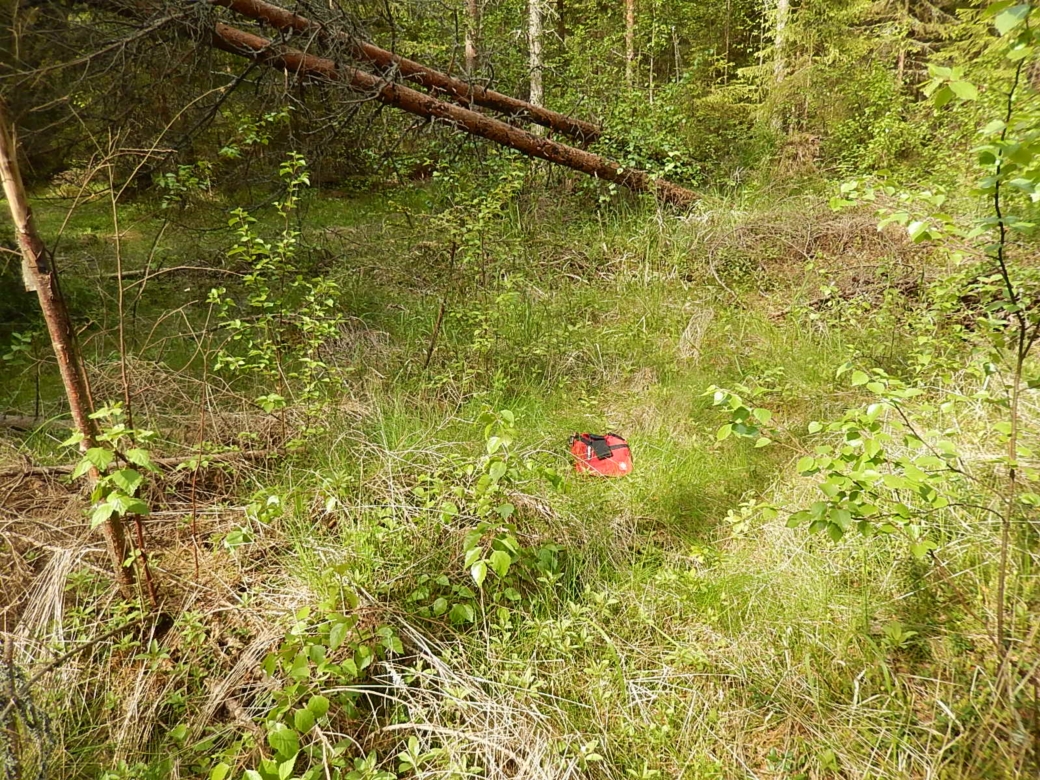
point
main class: Woodland
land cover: Other coniferous woodland
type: boreal forest
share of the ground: > 75 %
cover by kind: coniferous forest trees 70 %, broadleaved forest trees 10 %, shrubs 10 %, herbaceous plants 10 %
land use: Forestry
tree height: > 5 m
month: June
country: FI
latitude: 61.9155
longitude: 21.4912
